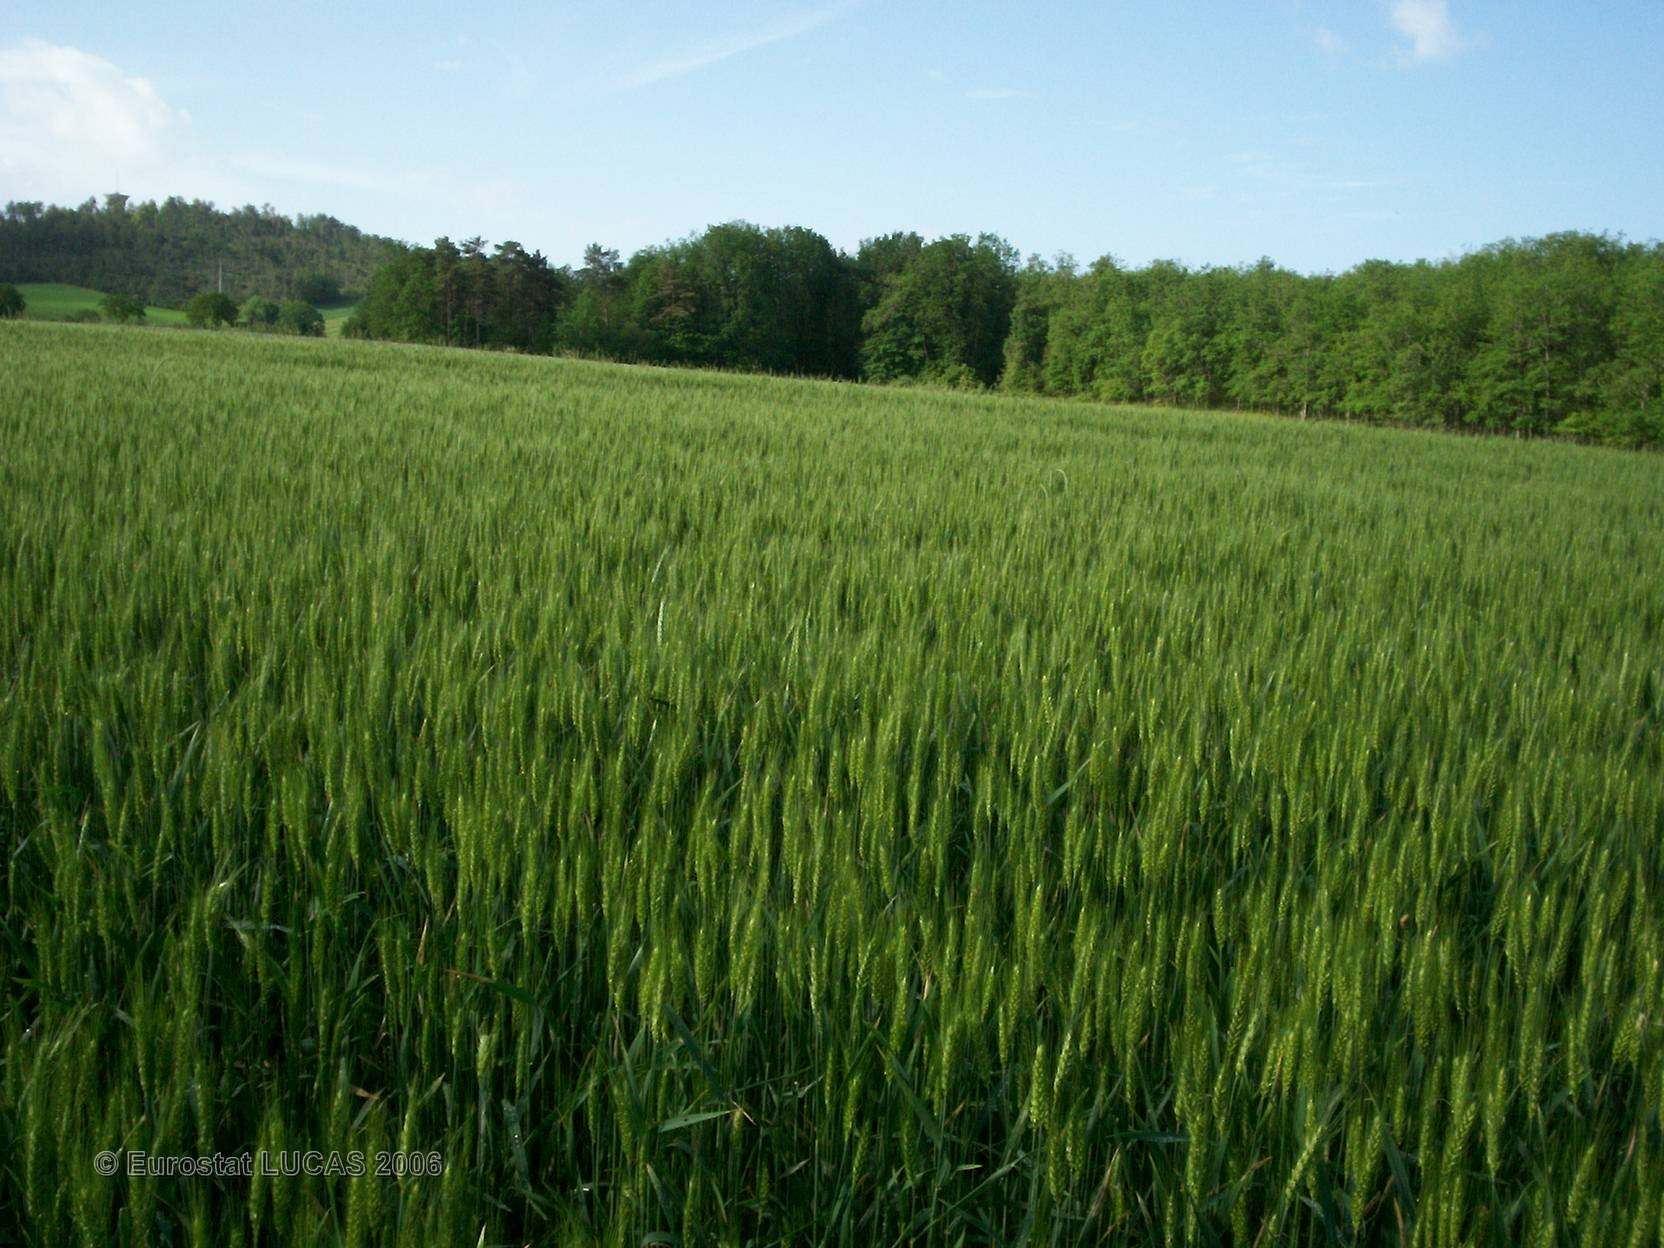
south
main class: Cropland
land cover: Triticale
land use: Agriculture (excluding fallow land and kitchen gardens)
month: May
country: FR
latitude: 45.3233
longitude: 0.6374
